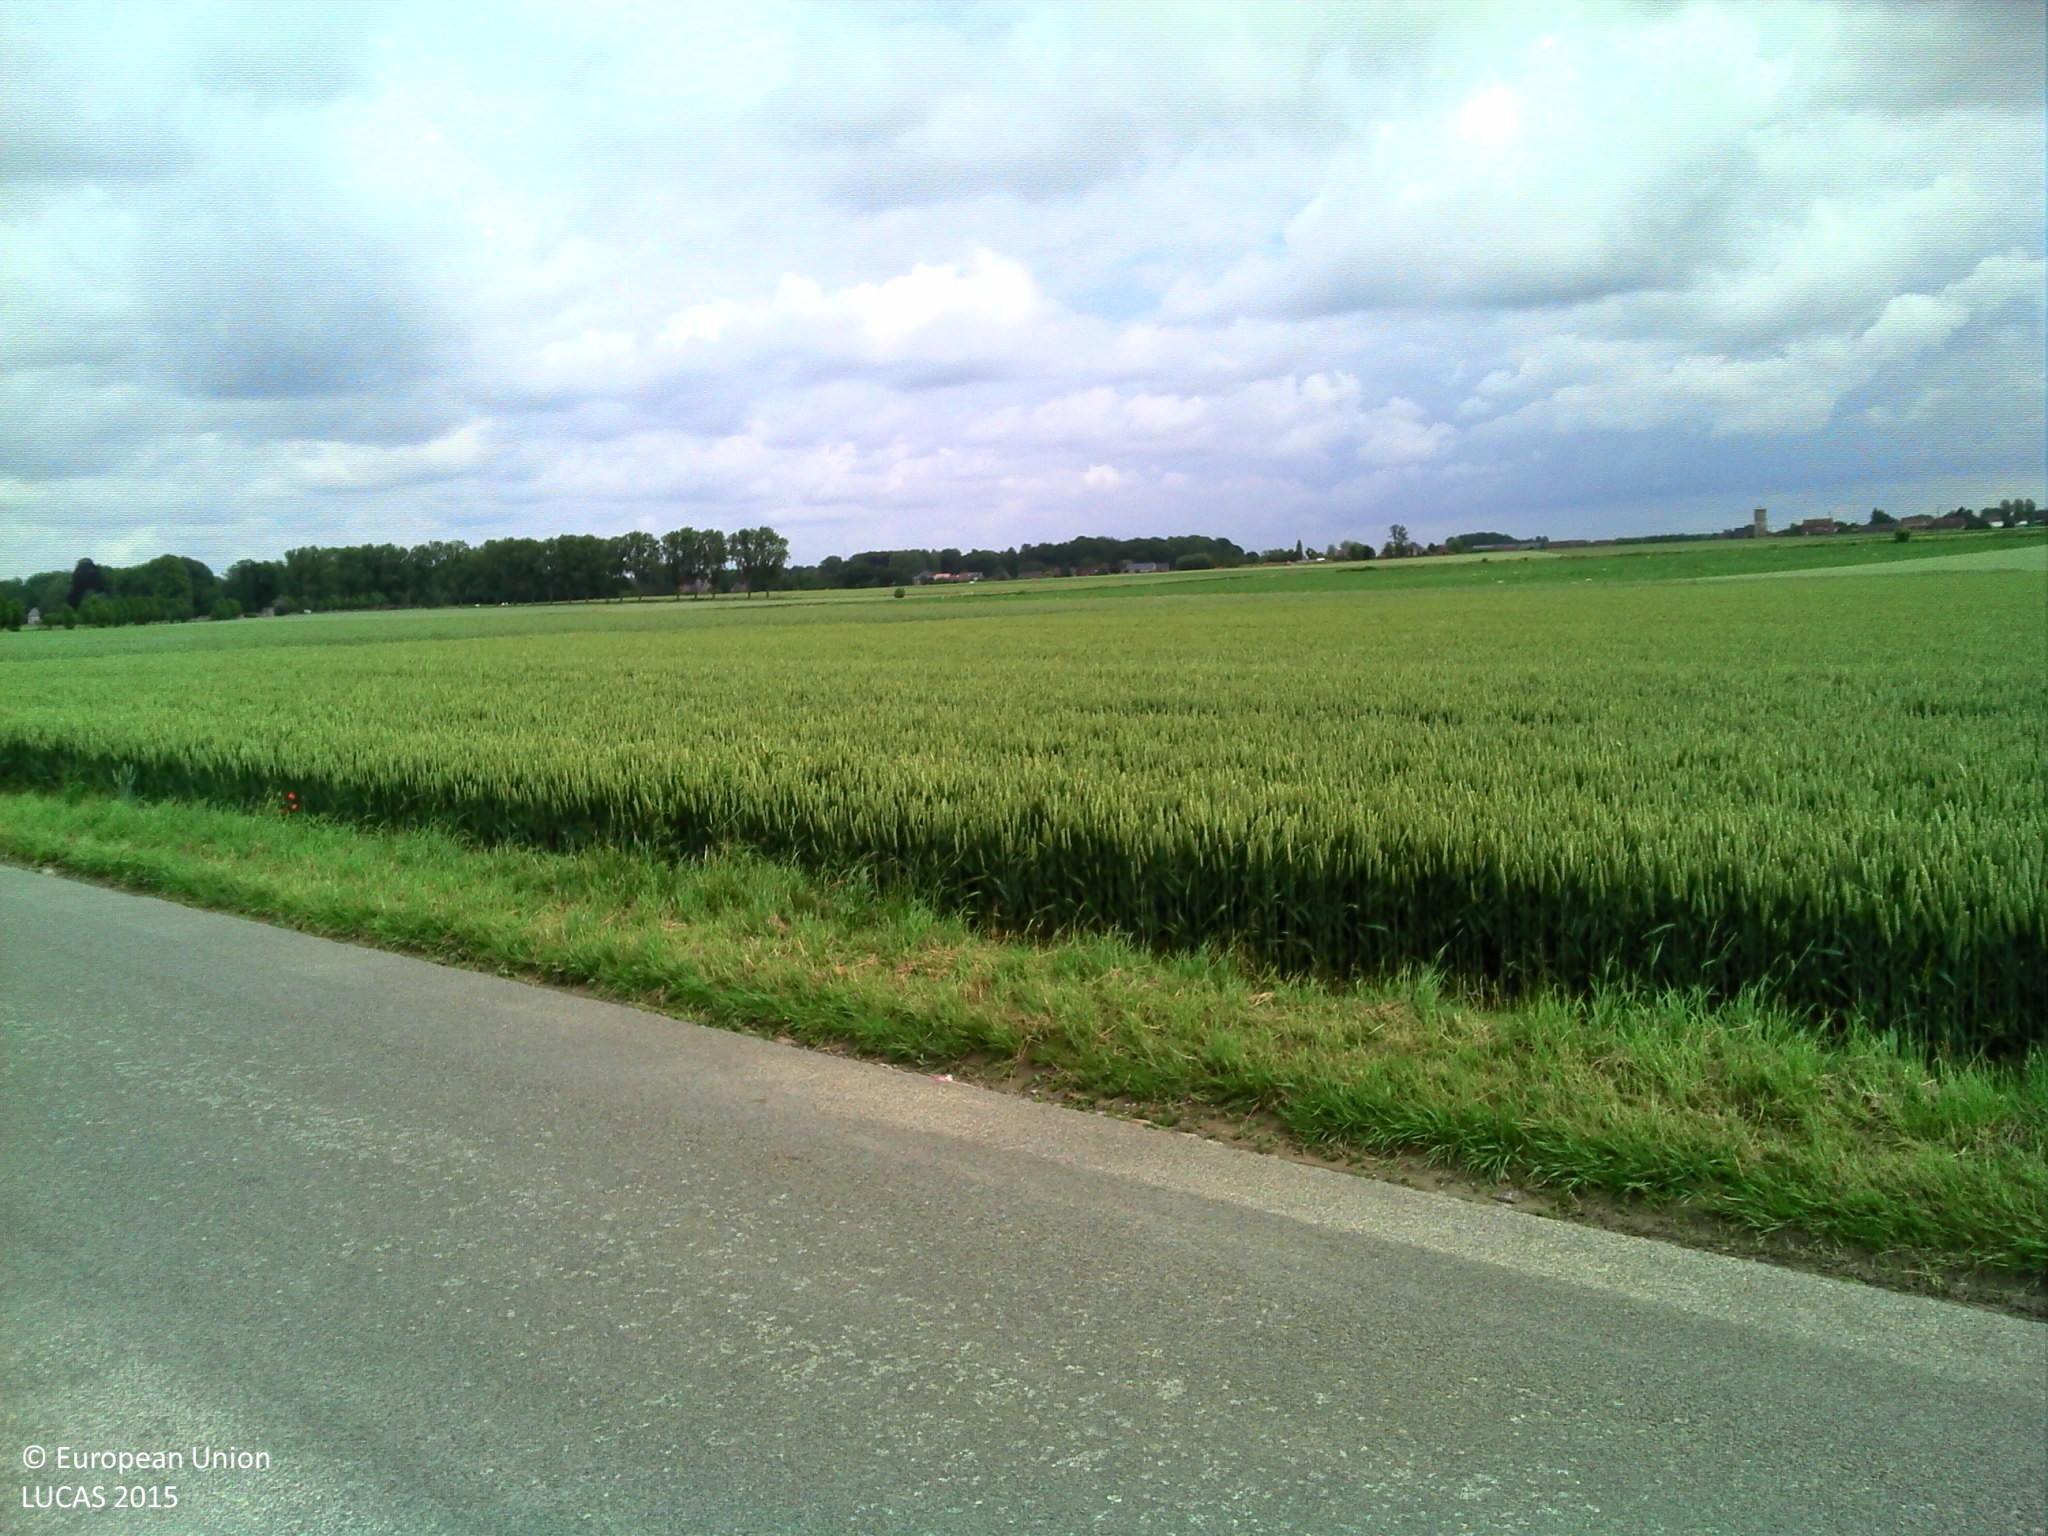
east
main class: Cropland
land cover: Potatoes
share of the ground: > 75 %
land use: Agriculture (excluding fallow land and kitchen gardens)
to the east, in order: Potatoes; Grass margins; Paved roads, cycling and walking lanes; Grass margins; Common wheat; Other cereals
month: June
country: BE
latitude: 50.5146
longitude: 4.0289
